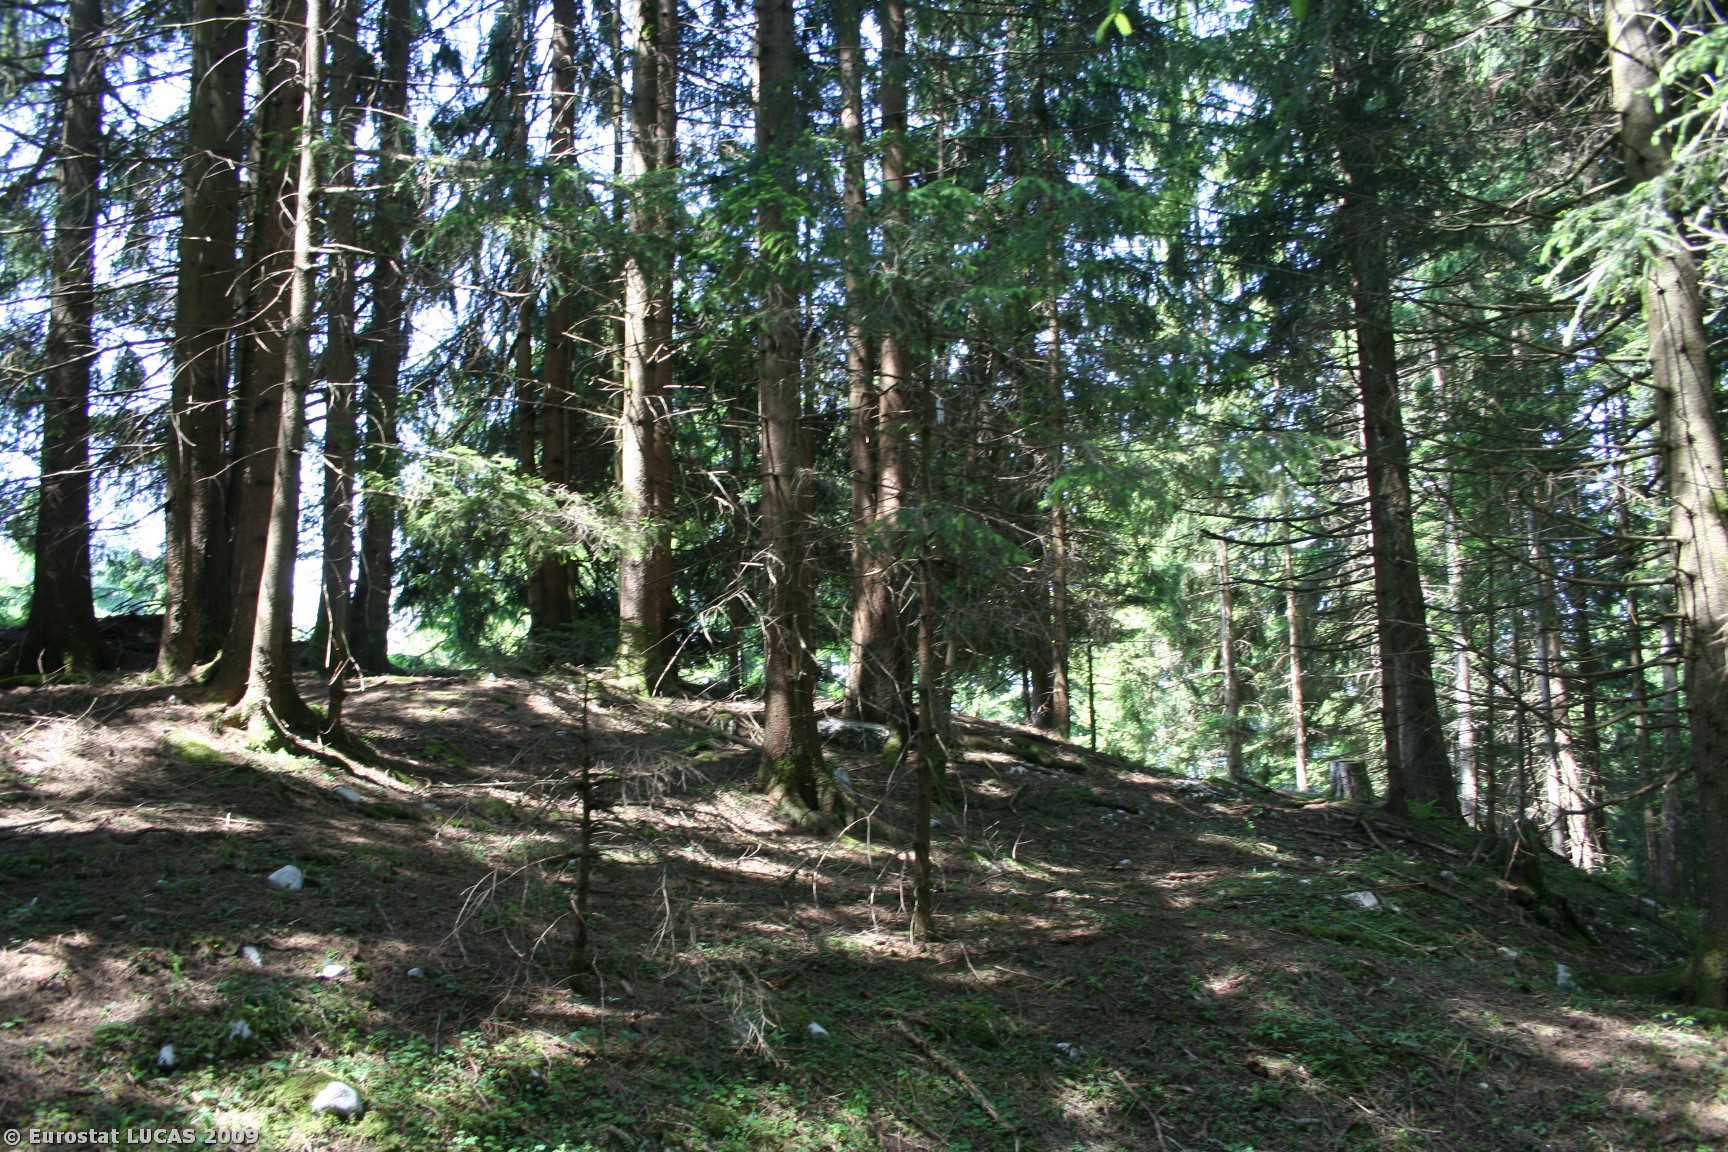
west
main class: Woodland
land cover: Coniferous woodland
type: alpine coniferous forest
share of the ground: > 75 %
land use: Forestry
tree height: > 5 m
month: May
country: AT
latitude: 47.6546
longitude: 13.2072
